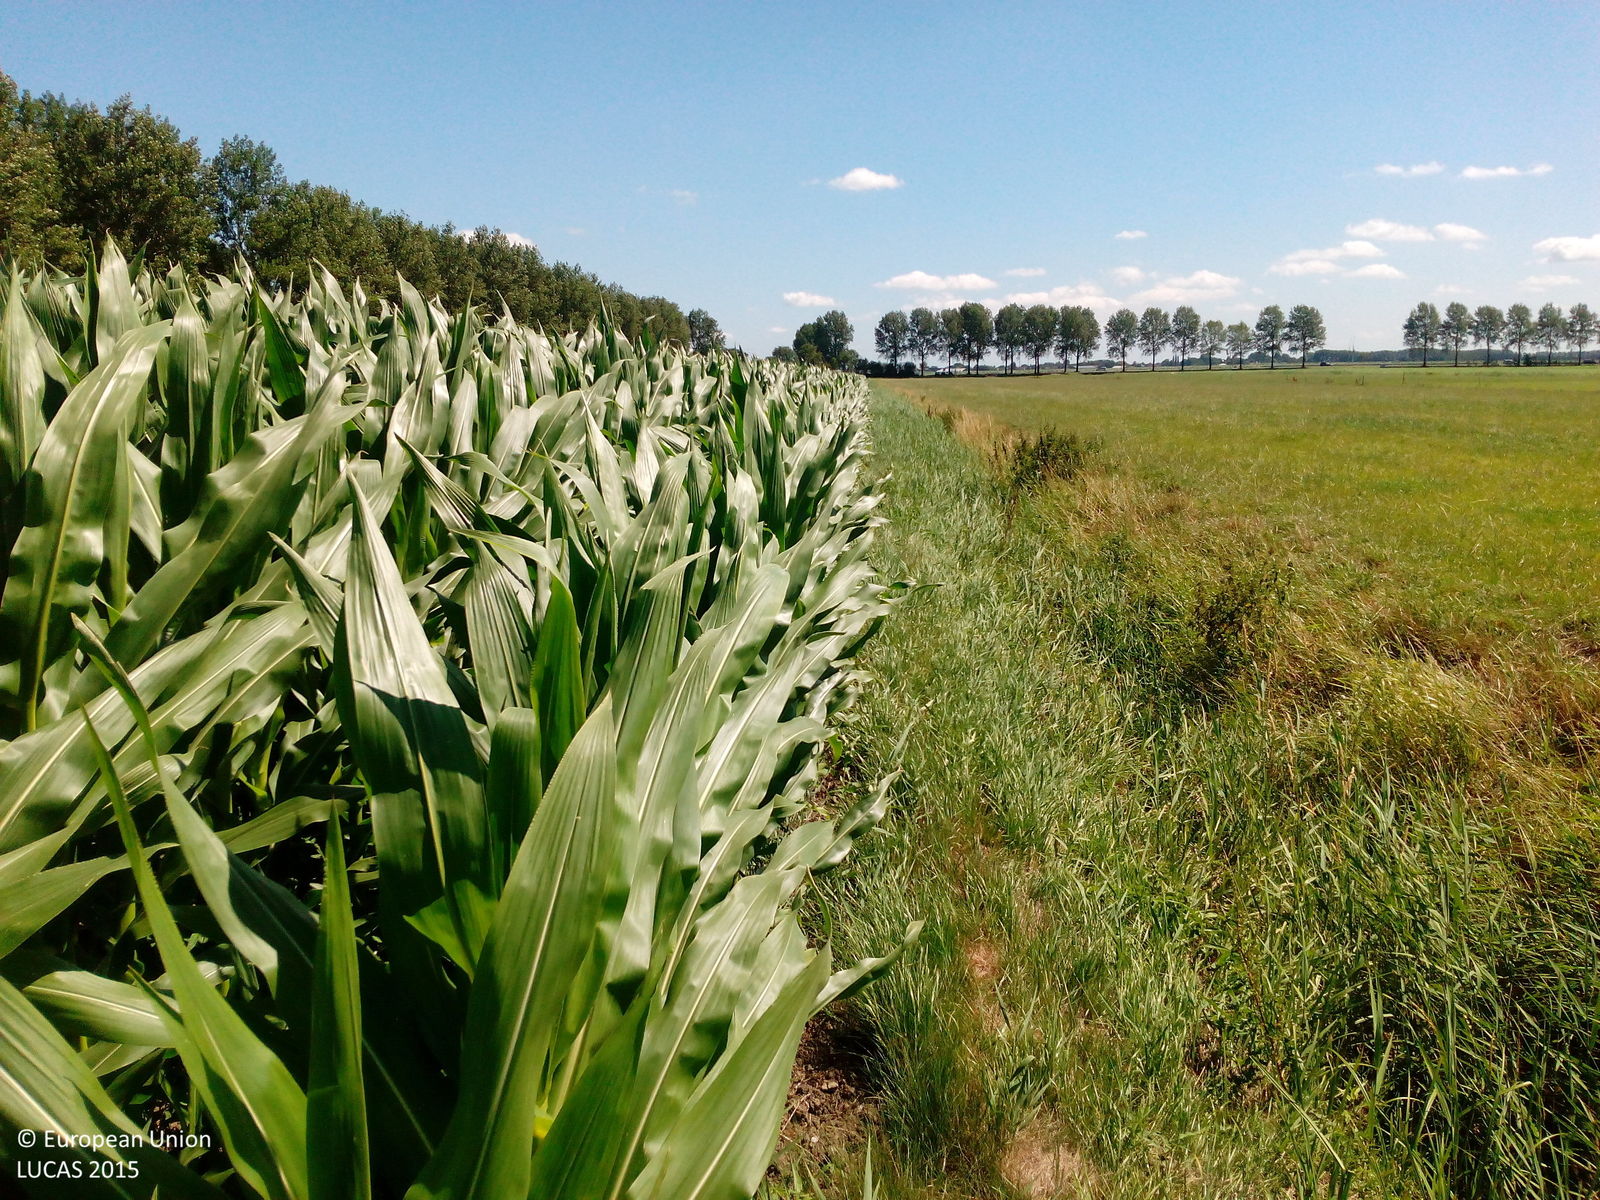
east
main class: Grassland
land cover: Grassland without tree/shrub cover
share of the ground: > 75 %
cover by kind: herbaceous plants 100 %
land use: Agriculture (excluding fallow land and kitchen gardens)
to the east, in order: Grassland without tree/shrub cover
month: July
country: NL
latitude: 52.1673
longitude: 4.6599
